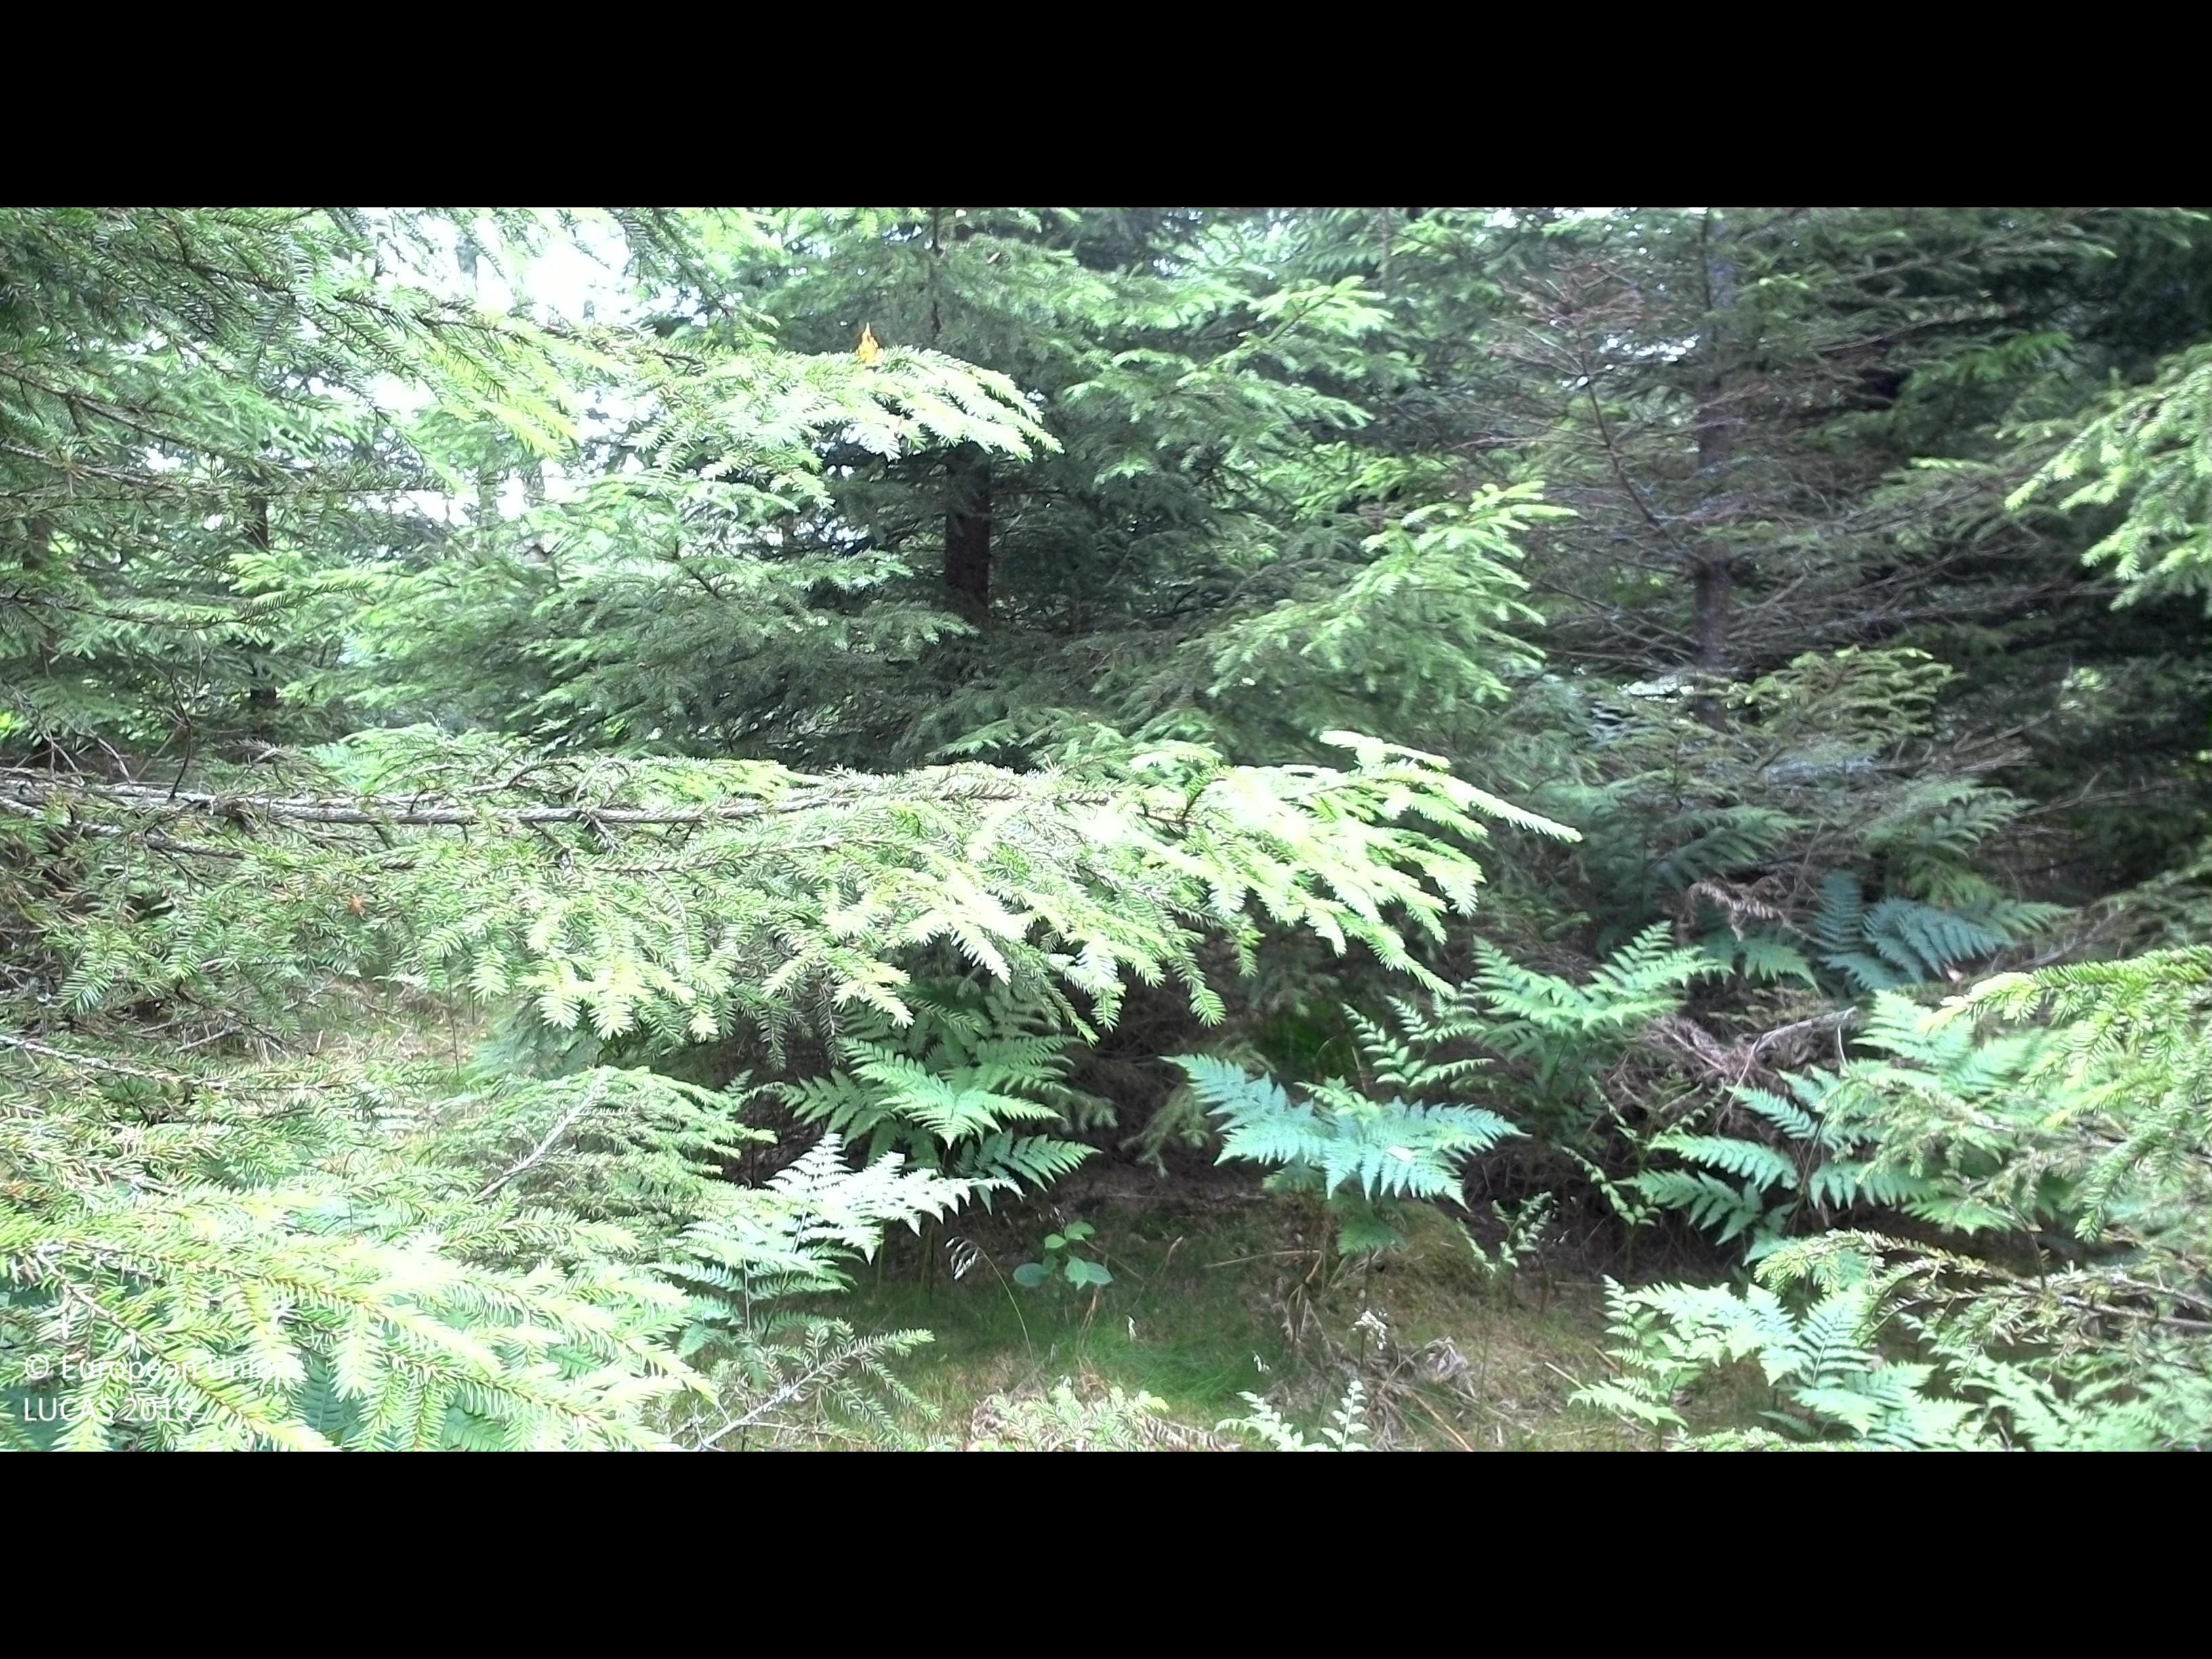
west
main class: Woodland
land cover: Spruce dominated coniferous woodland
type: boreal forest
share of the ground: > 75 %
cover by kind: coniferous forest trees 75 %, shrubs 10 %, herbaceous plants 10 %, broadleaved forest trees 5 %
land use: Forestry
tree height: < 5 m
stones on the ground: < 10 %
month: July
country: SE
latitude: 56.4959
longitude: 14.7571
